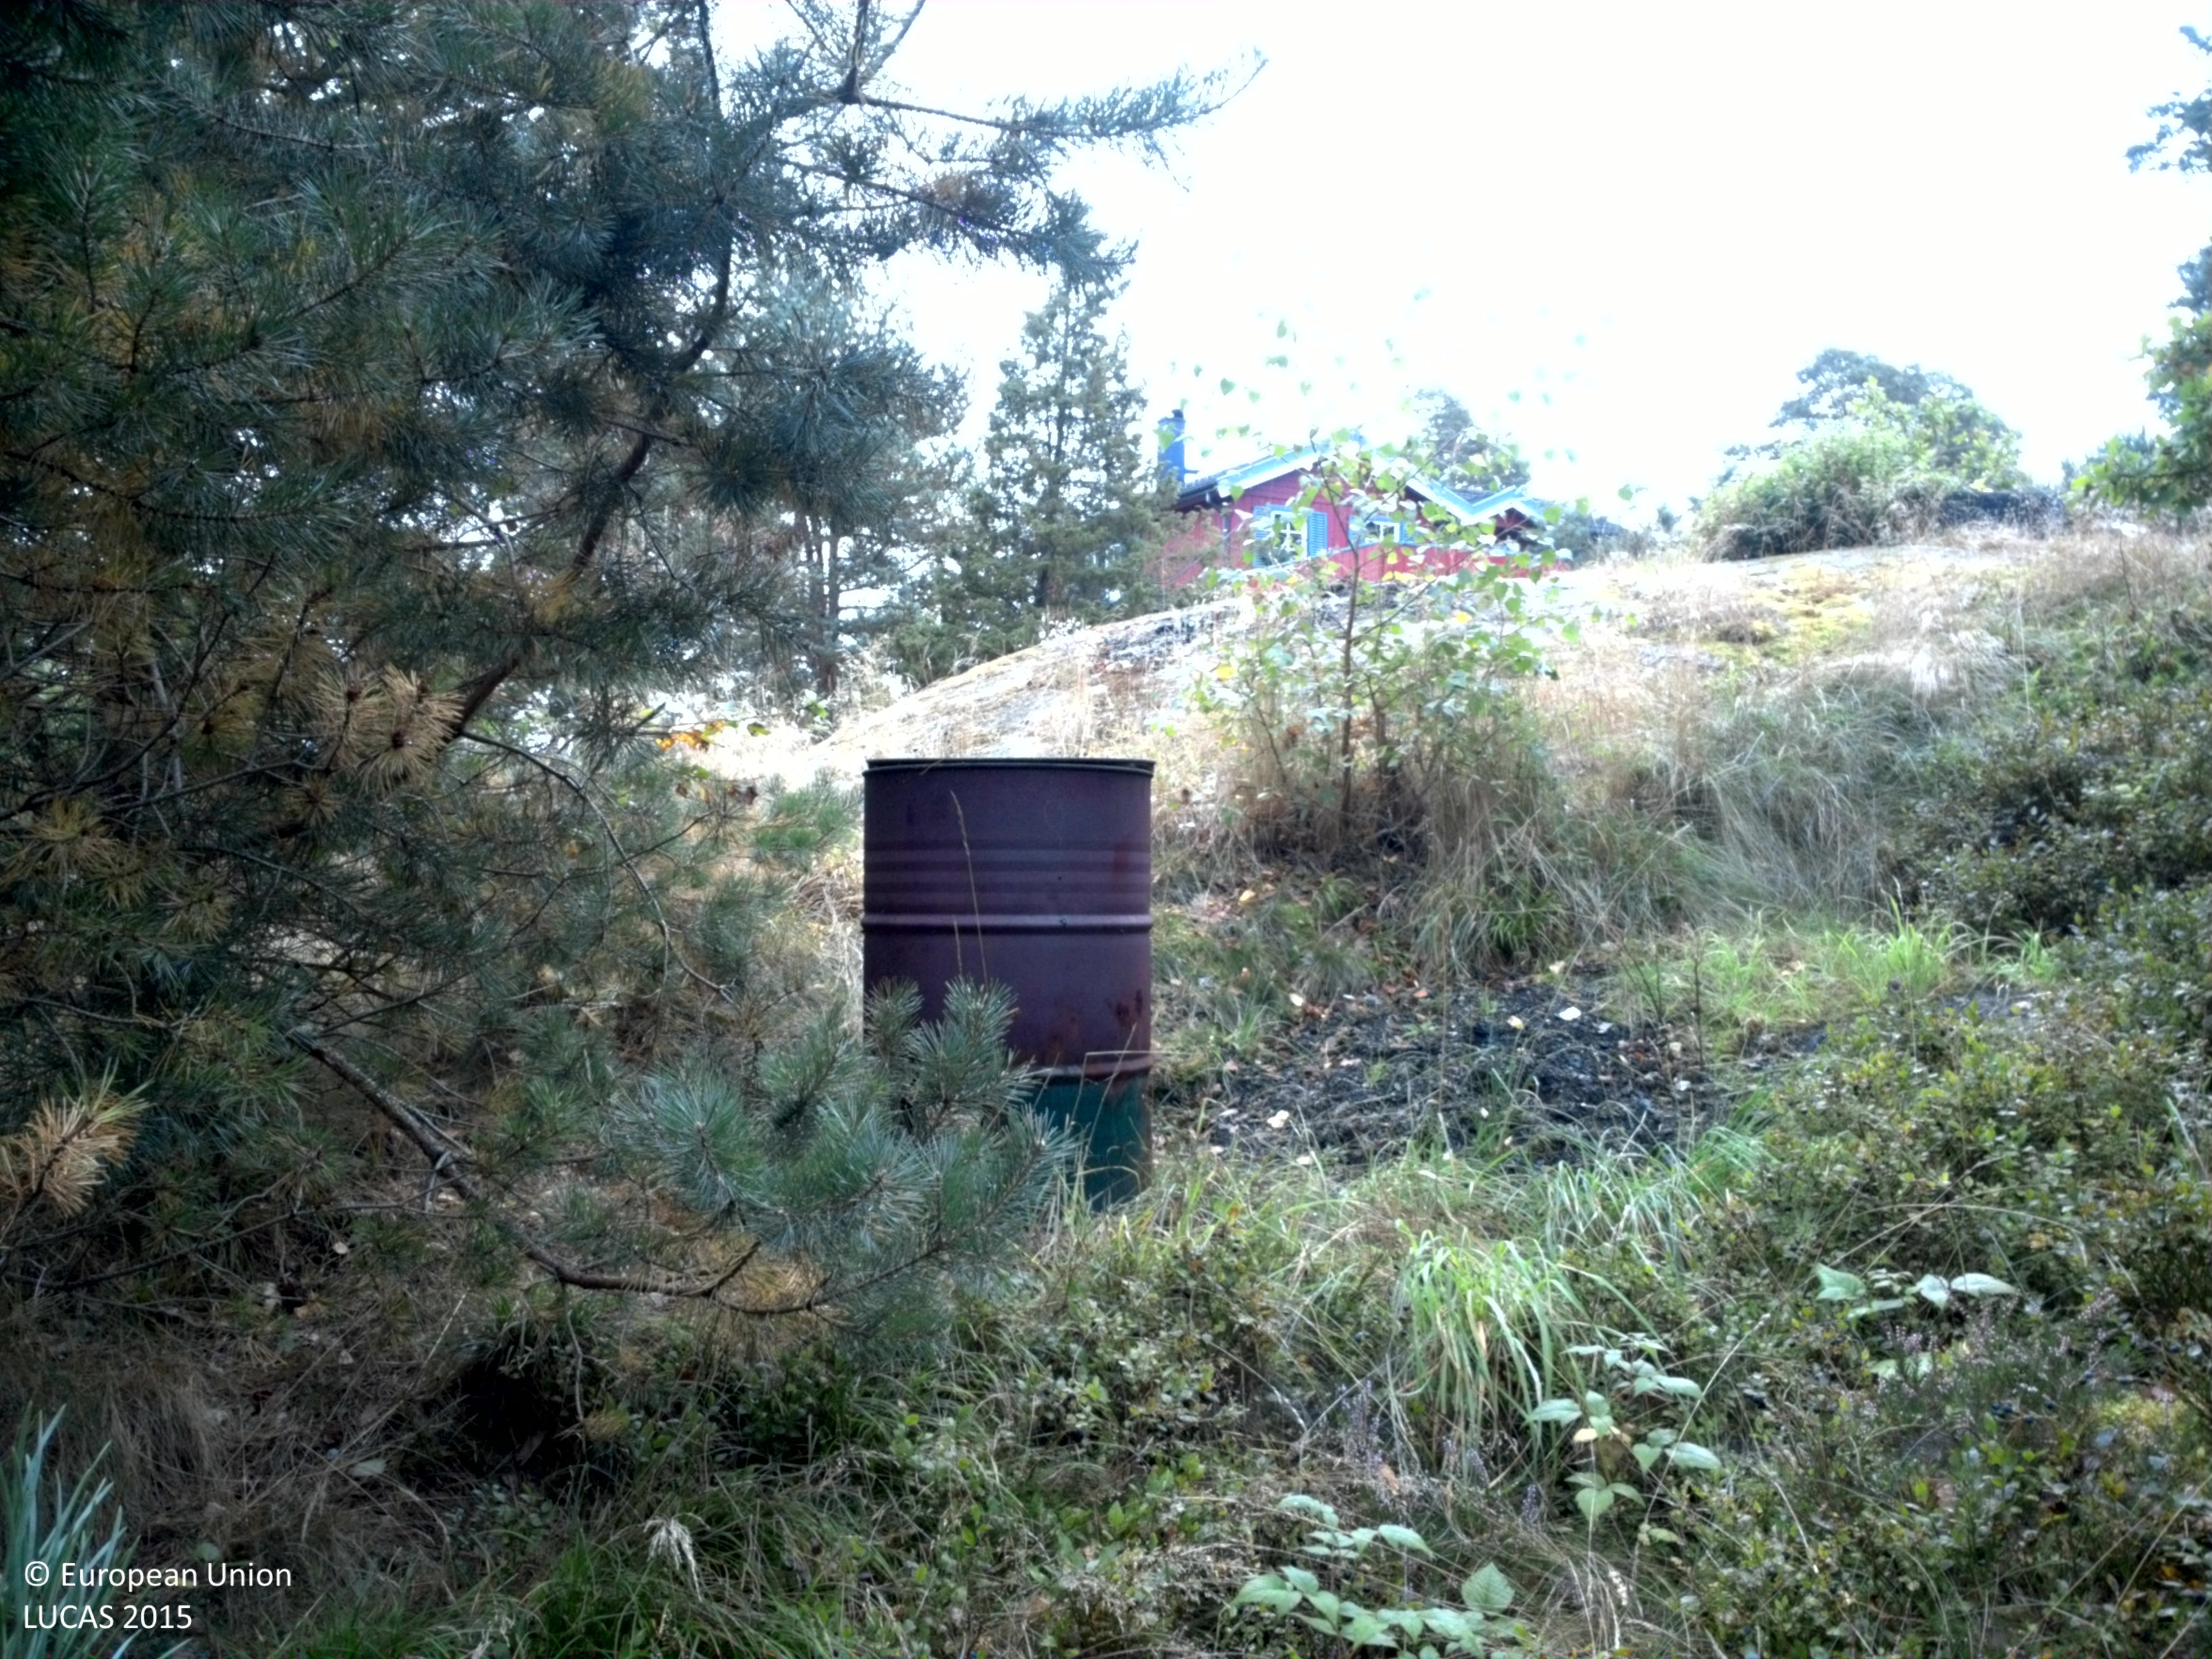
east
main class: Woodland
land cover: Pine dominated mixed woodland
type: boreal forest
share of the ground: < 10 %
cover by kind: lichens and mosses 35 %, consolidated bare surface 20 %, coniferous forest trees 15 %, shrubs 15 %, herbaceous plants 10 %, broadleaved forest trees 5 %
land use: Residential
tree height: > 5 m
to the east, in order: Pine dominated mixed woodland; Artificial constructions in urban areas; Pine dominated coniferous woodland; Artificial constructions in urban areas; Pine dominated coniferous woodland; Rocks and stones
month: September
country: SE
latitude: 59.3695
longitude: 18.6768
